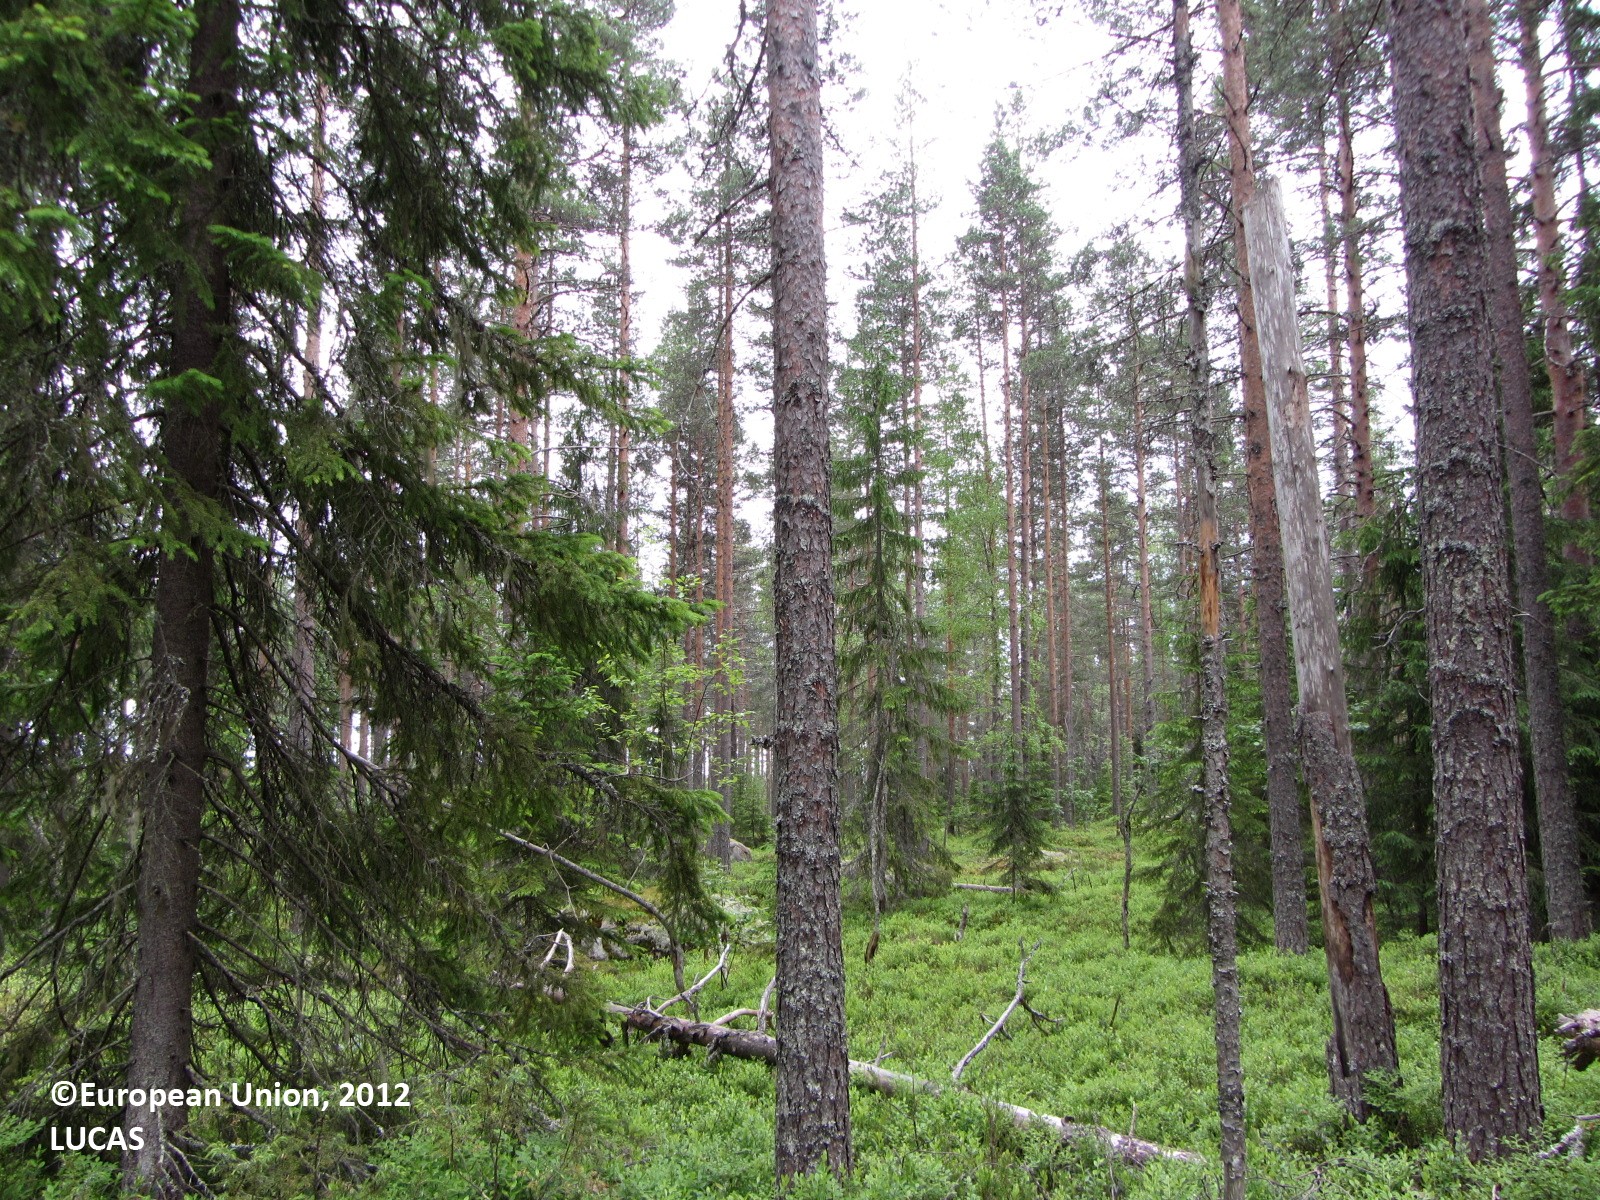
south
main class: Woodland
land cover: Pine dominated coniferous woodland
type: boreal forest
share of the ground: 50 - 75 %
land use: Forestry
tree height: > 5 m
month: June
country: FI
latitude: 62.7516
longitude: 25.5974
